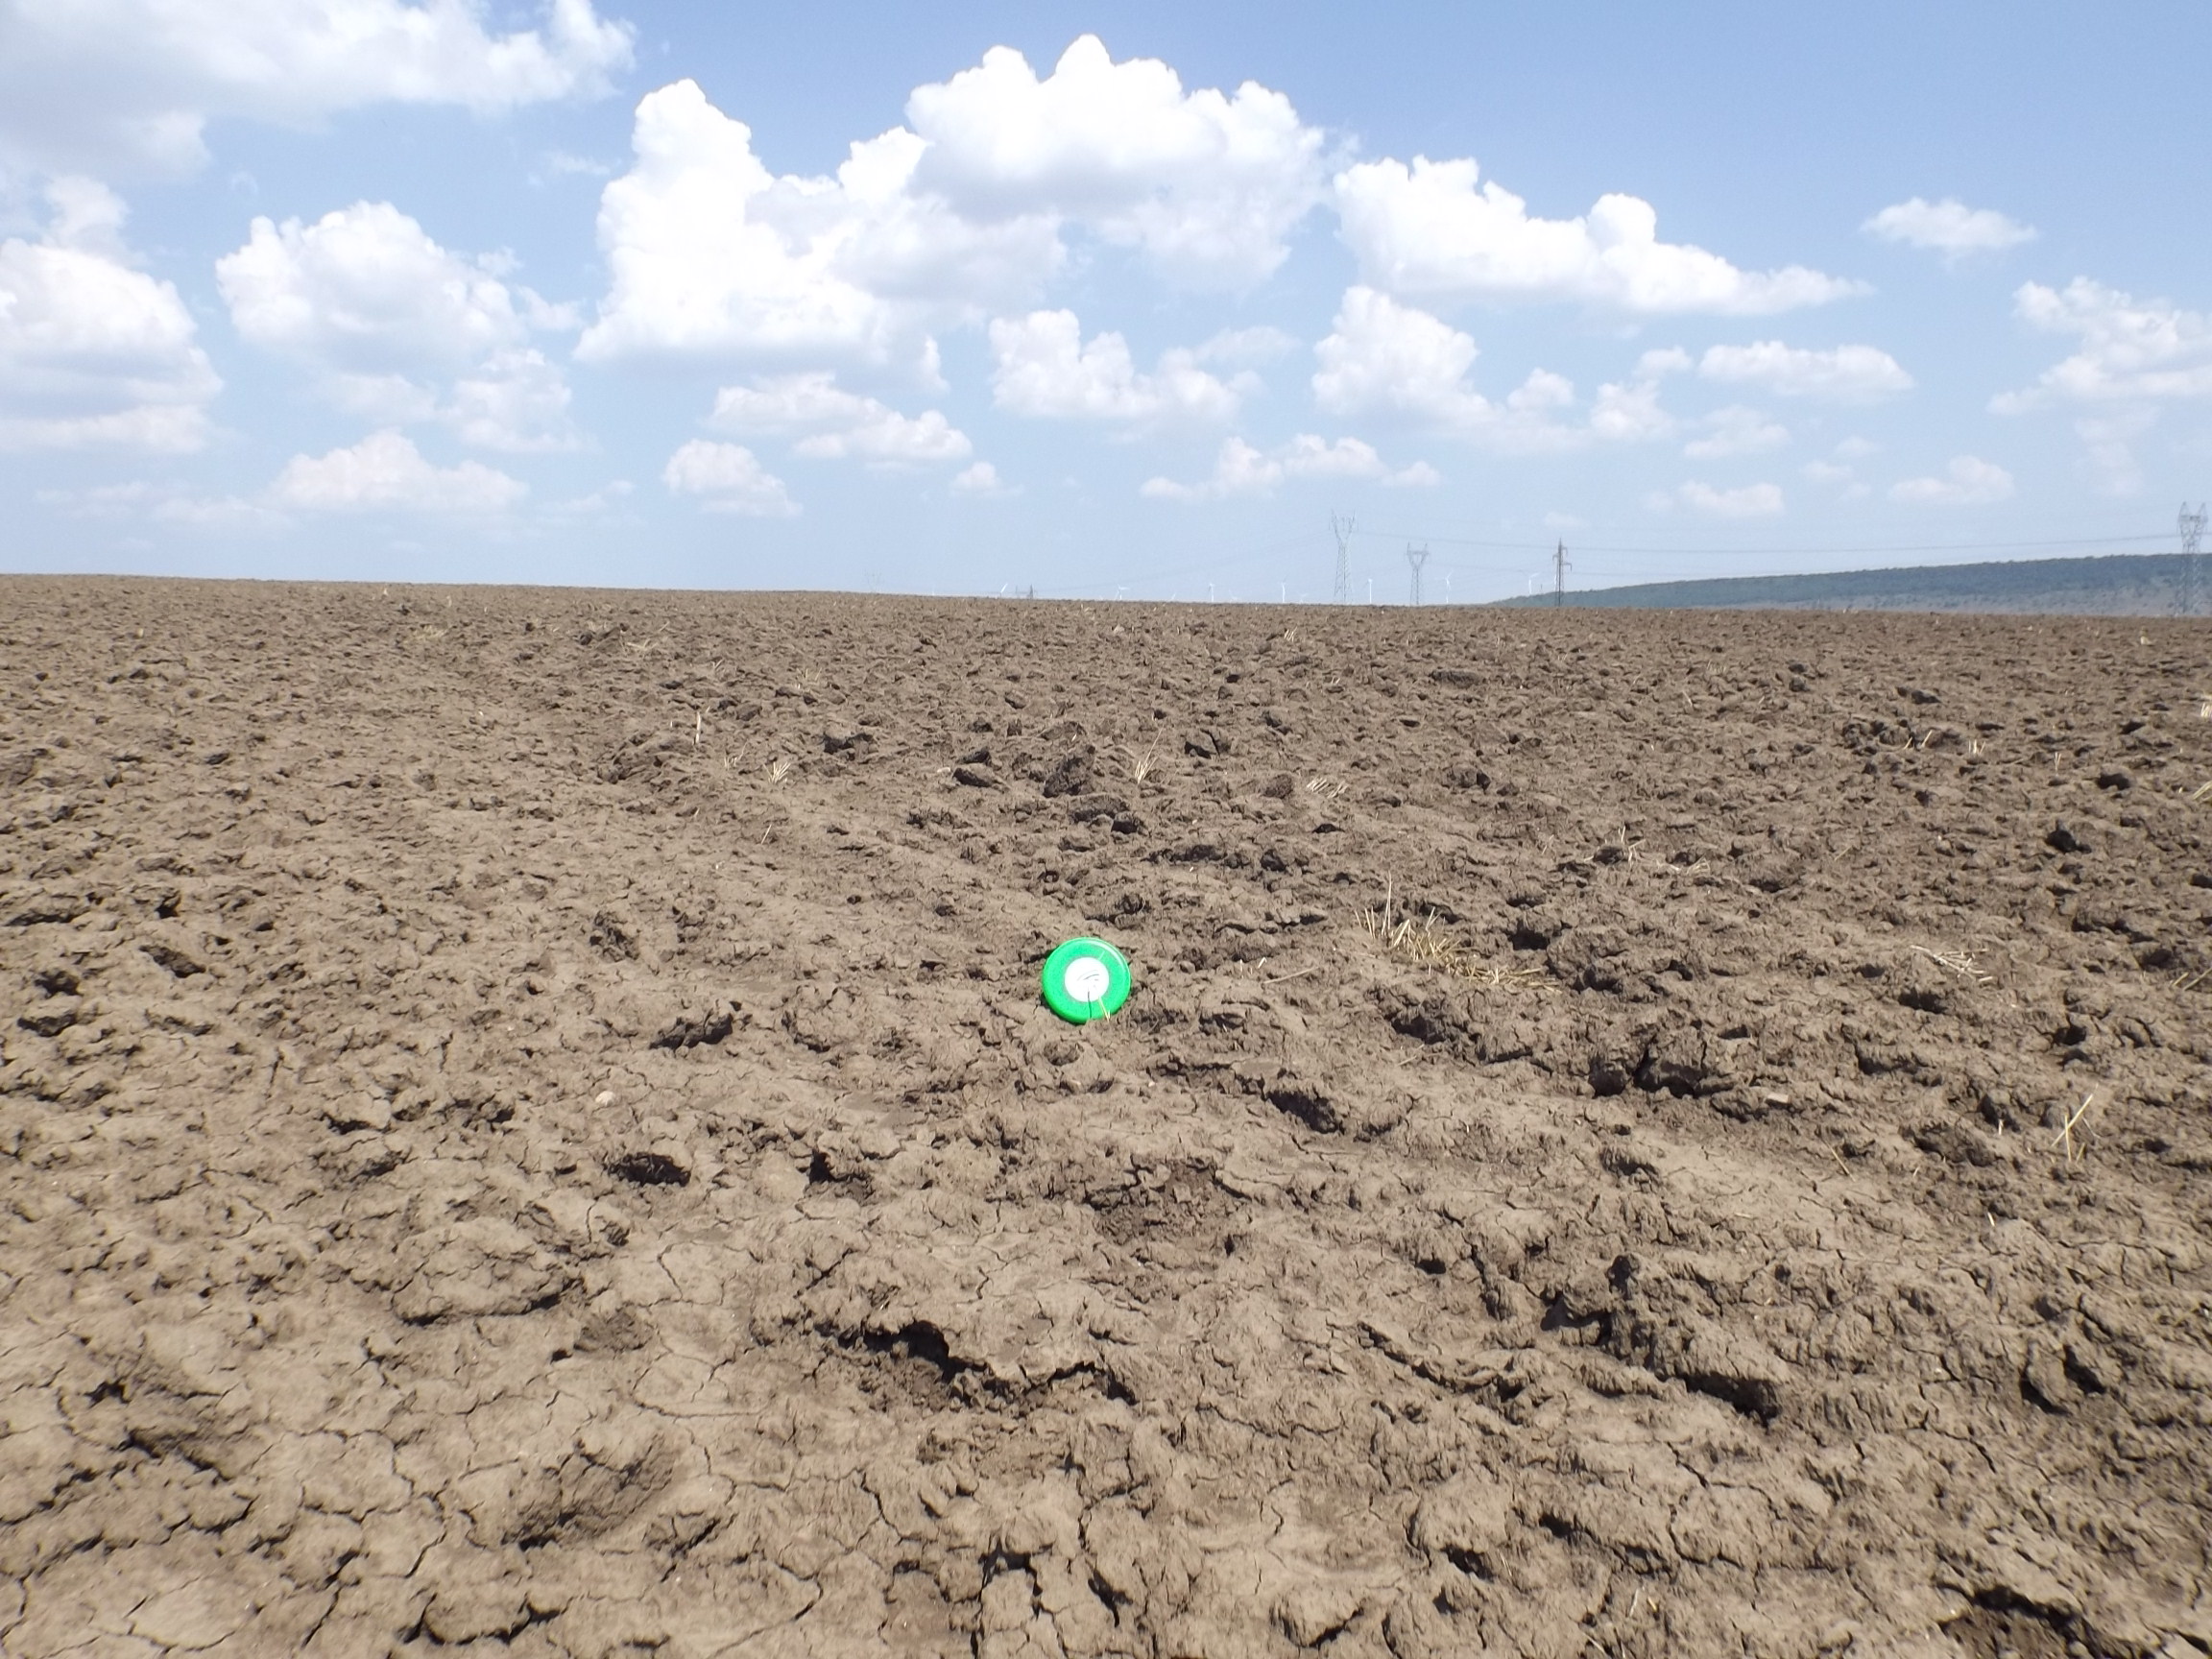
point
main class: Cropland
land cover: Common wheat
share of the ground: < 10 %
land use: Agriculture (excluding fallow land and kitchen gardens)
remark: Harvested field
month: August
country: BG
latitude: 43.3147
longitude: 27.5776
